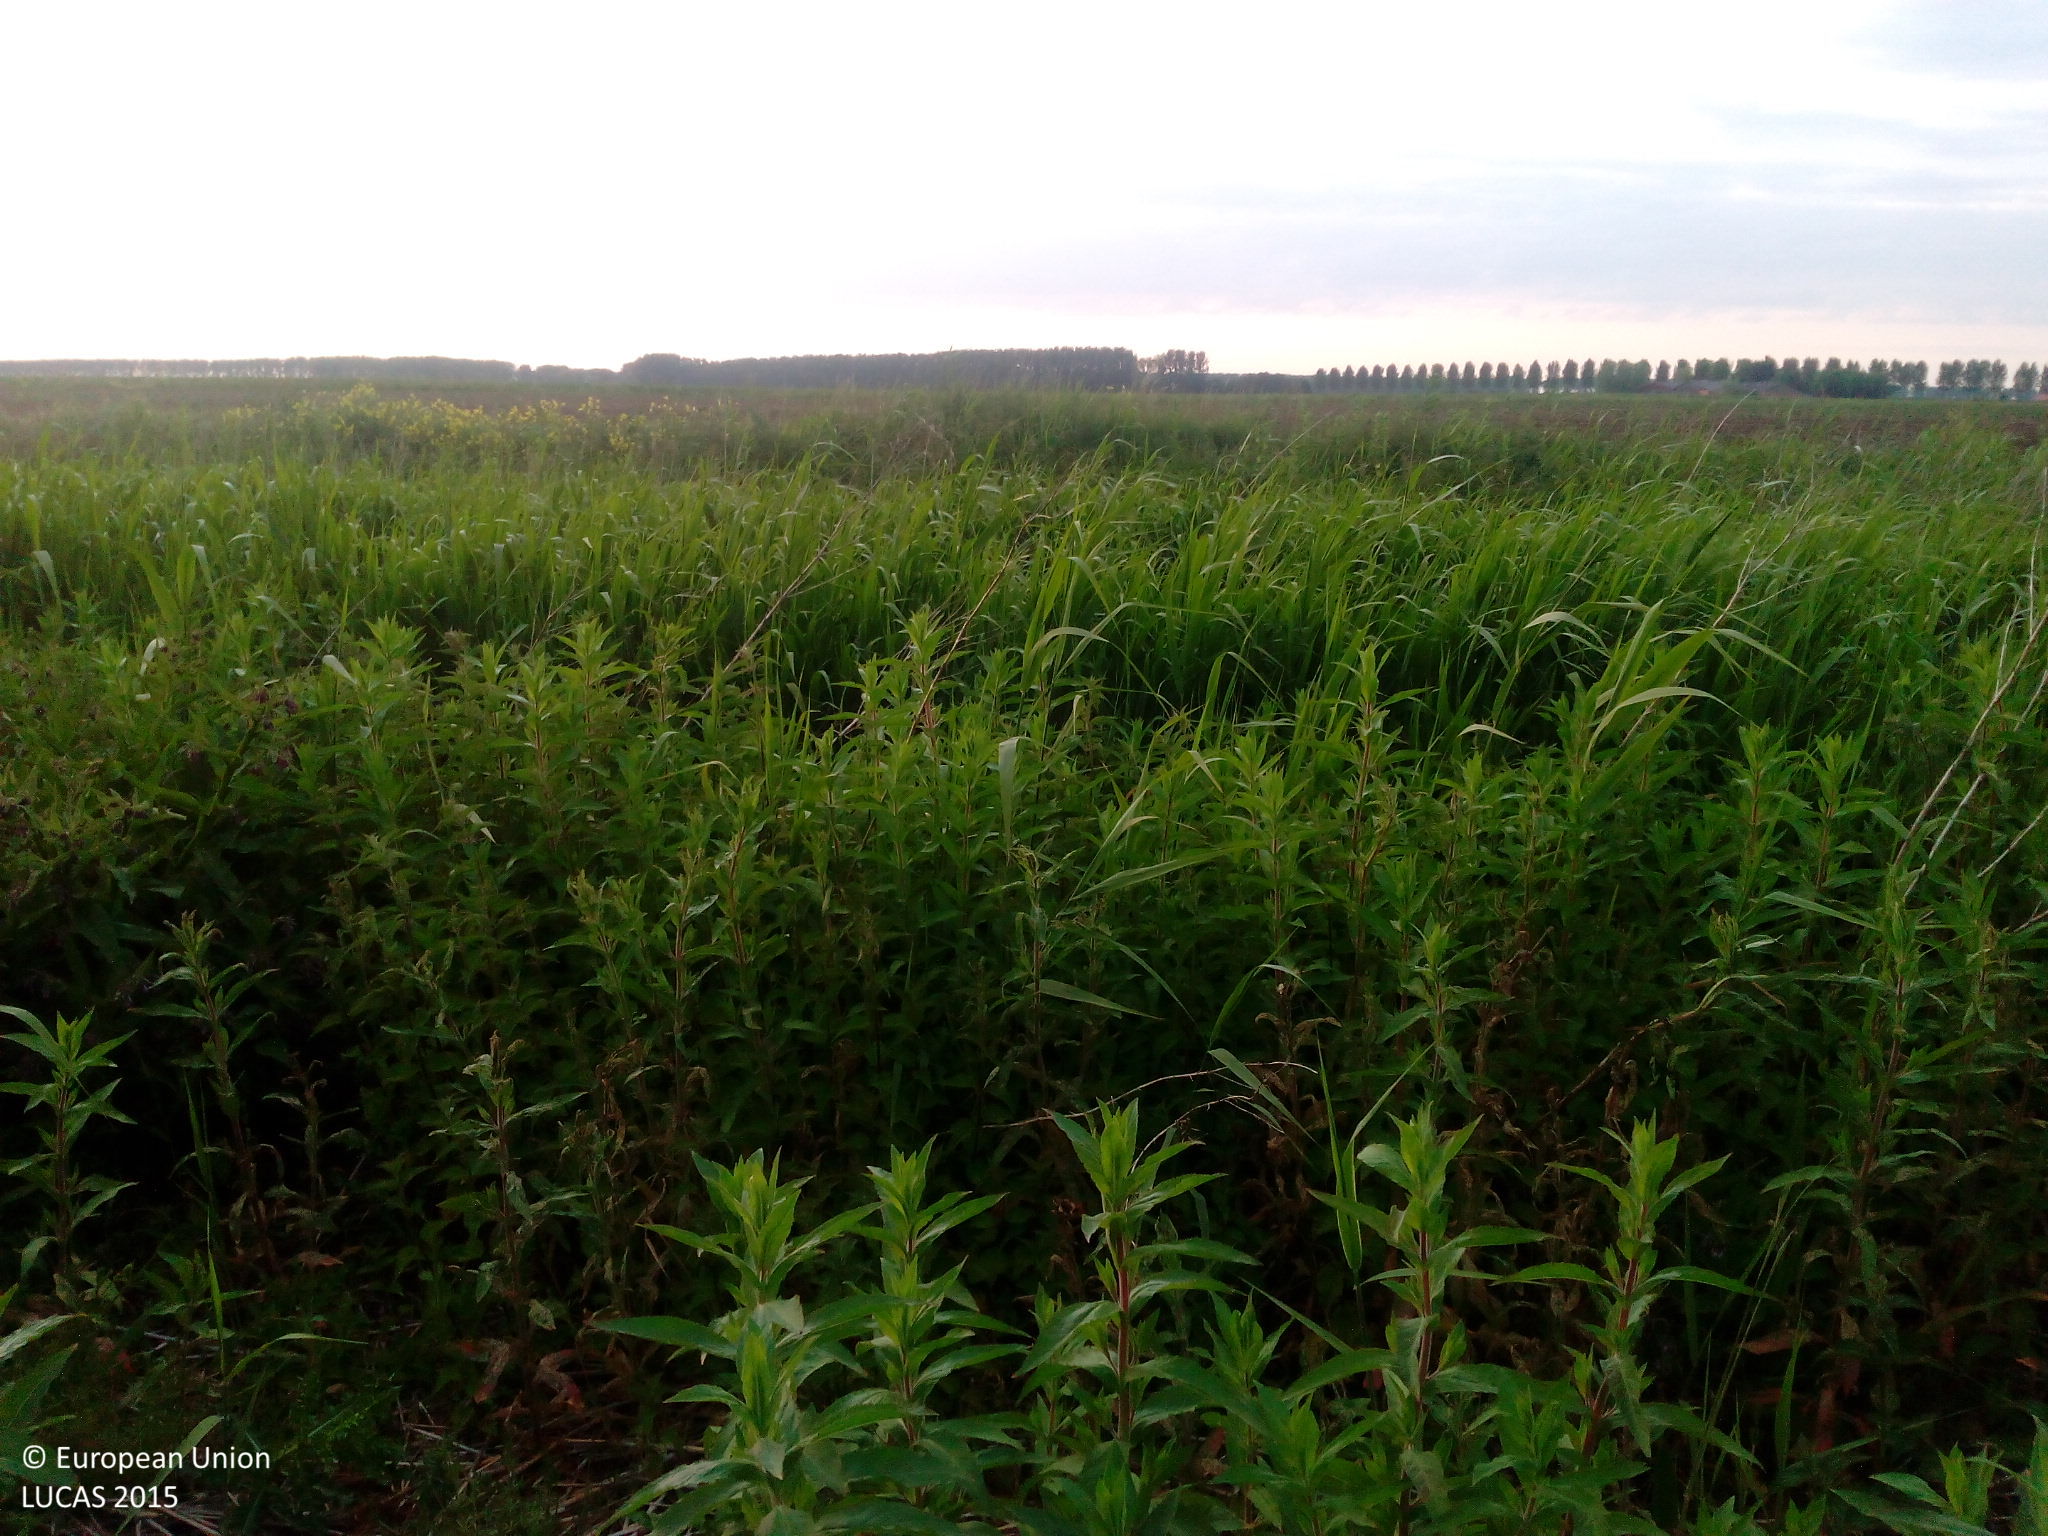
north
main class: Grassland
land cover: Spontaneously vegetated surfaces
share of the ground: 50 - 75 %
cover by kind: herbaceous plants 100 %
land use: Semi-natural and natural areas not in use
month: May
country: NL
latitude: 51.2950
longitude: 4.1291
